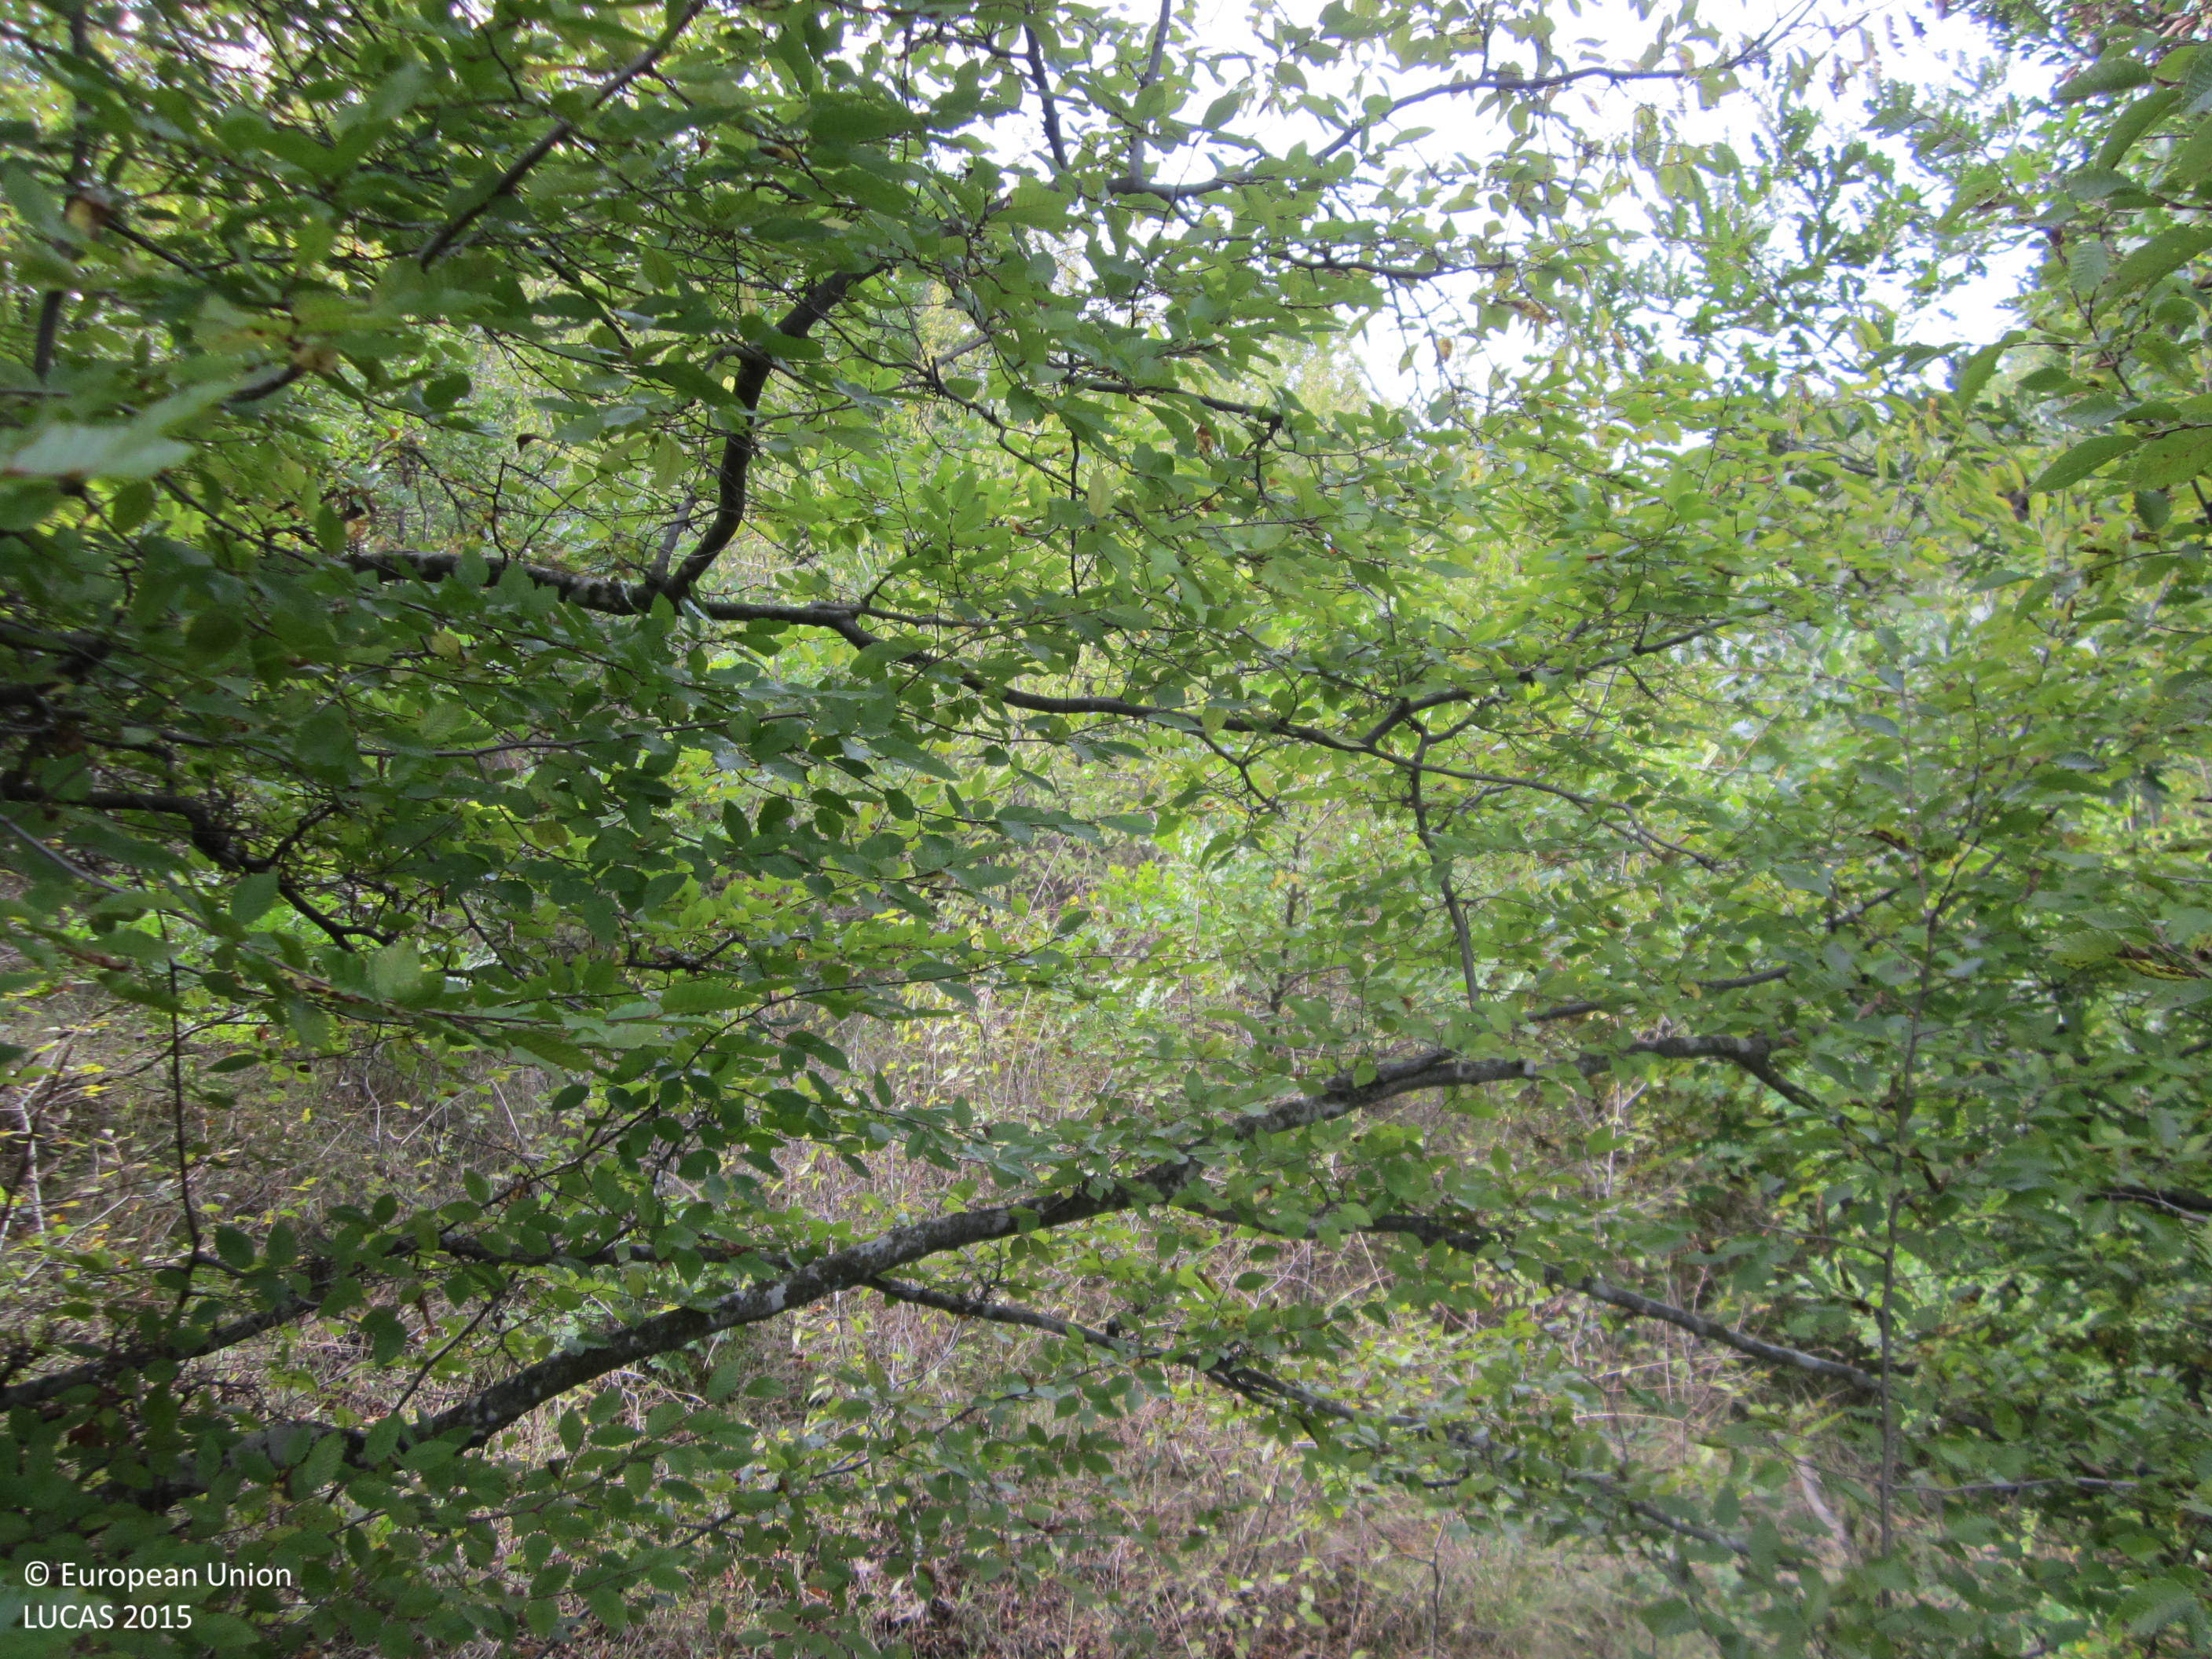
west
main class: Woodland
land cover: Broadleaved woodland
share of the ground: 50 - 75 %
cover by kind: broadleaved forest trees 70 %, herbaceous plants 20 %, shrubs 10 %
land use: Semi-natural and natural areas not in use
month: October
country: BG
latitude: 42.7867
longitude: 26.7895
